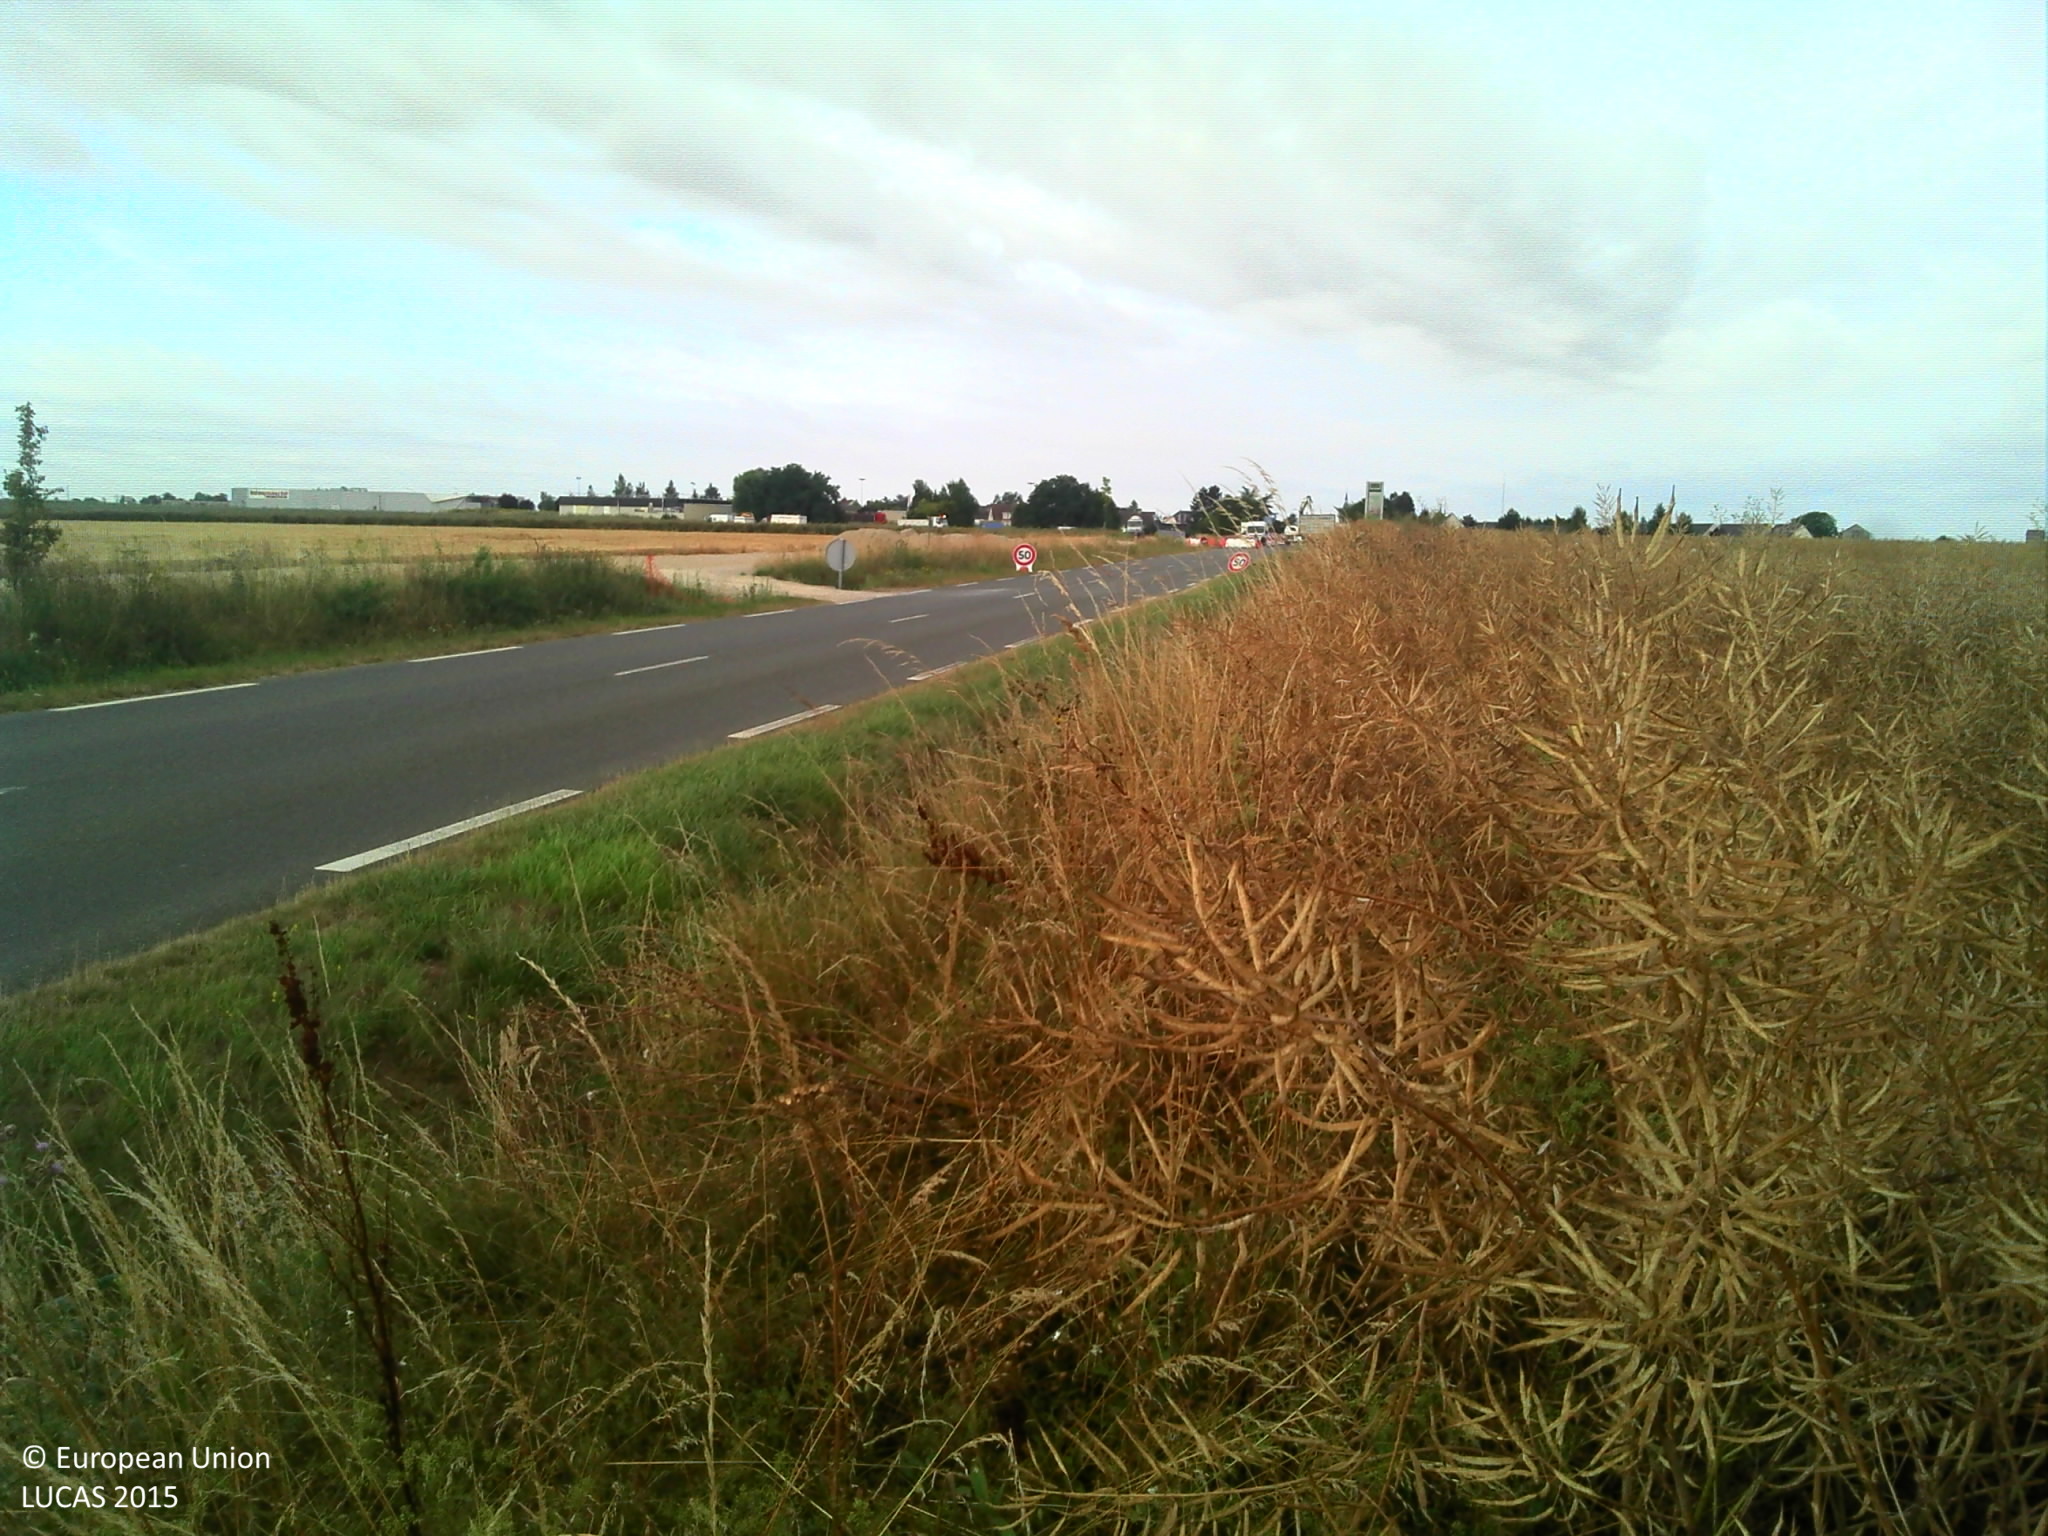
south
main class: Cropland
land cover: Rape and turnip rape
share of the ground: > 75 %
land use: Agriculture (excluding fallow land and kitchen gardens)
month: July
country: FR
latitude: 48.3101
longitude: 1.2581
